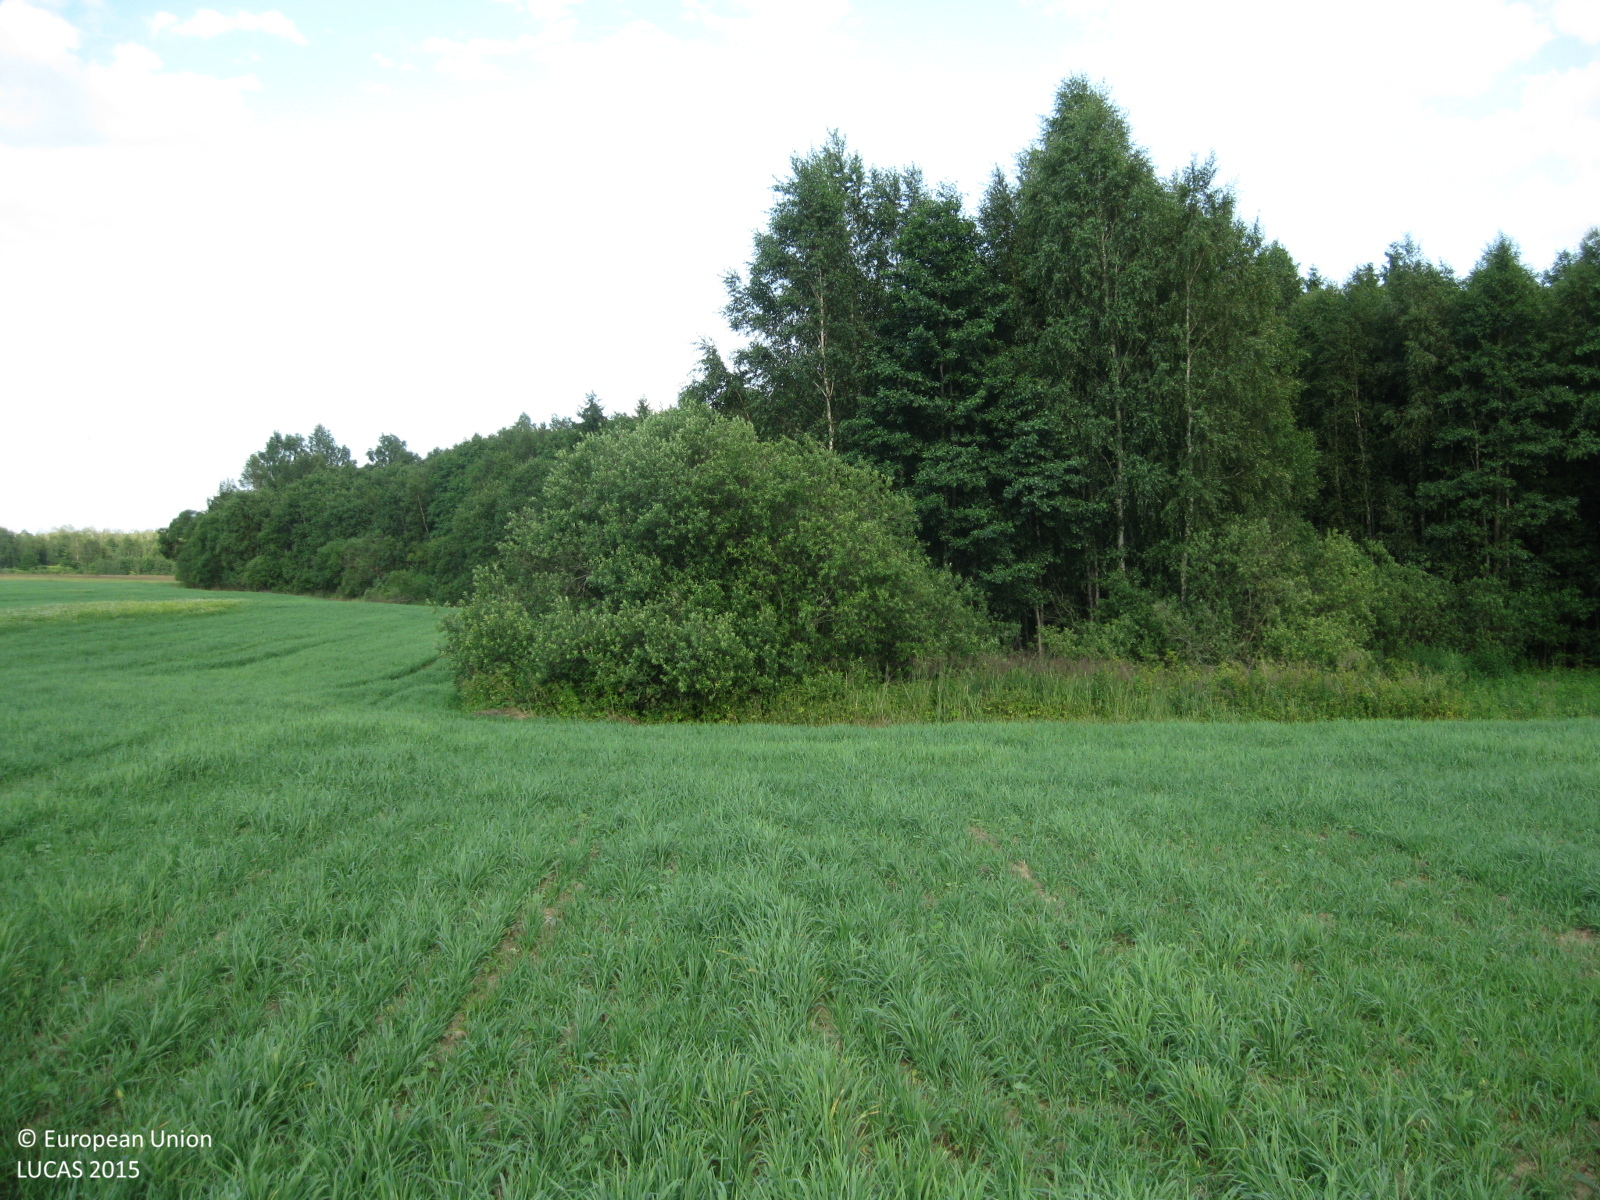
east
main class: Cropland
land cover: Barley
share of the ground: > 75 %
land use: Agriculture (excluding fallow land and kitchen gardens)
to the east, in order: Barley; Broadleaved woodland; Spruce dominated mixed woodland
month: July
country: LT
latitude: 55.4697
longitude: 24.6406
